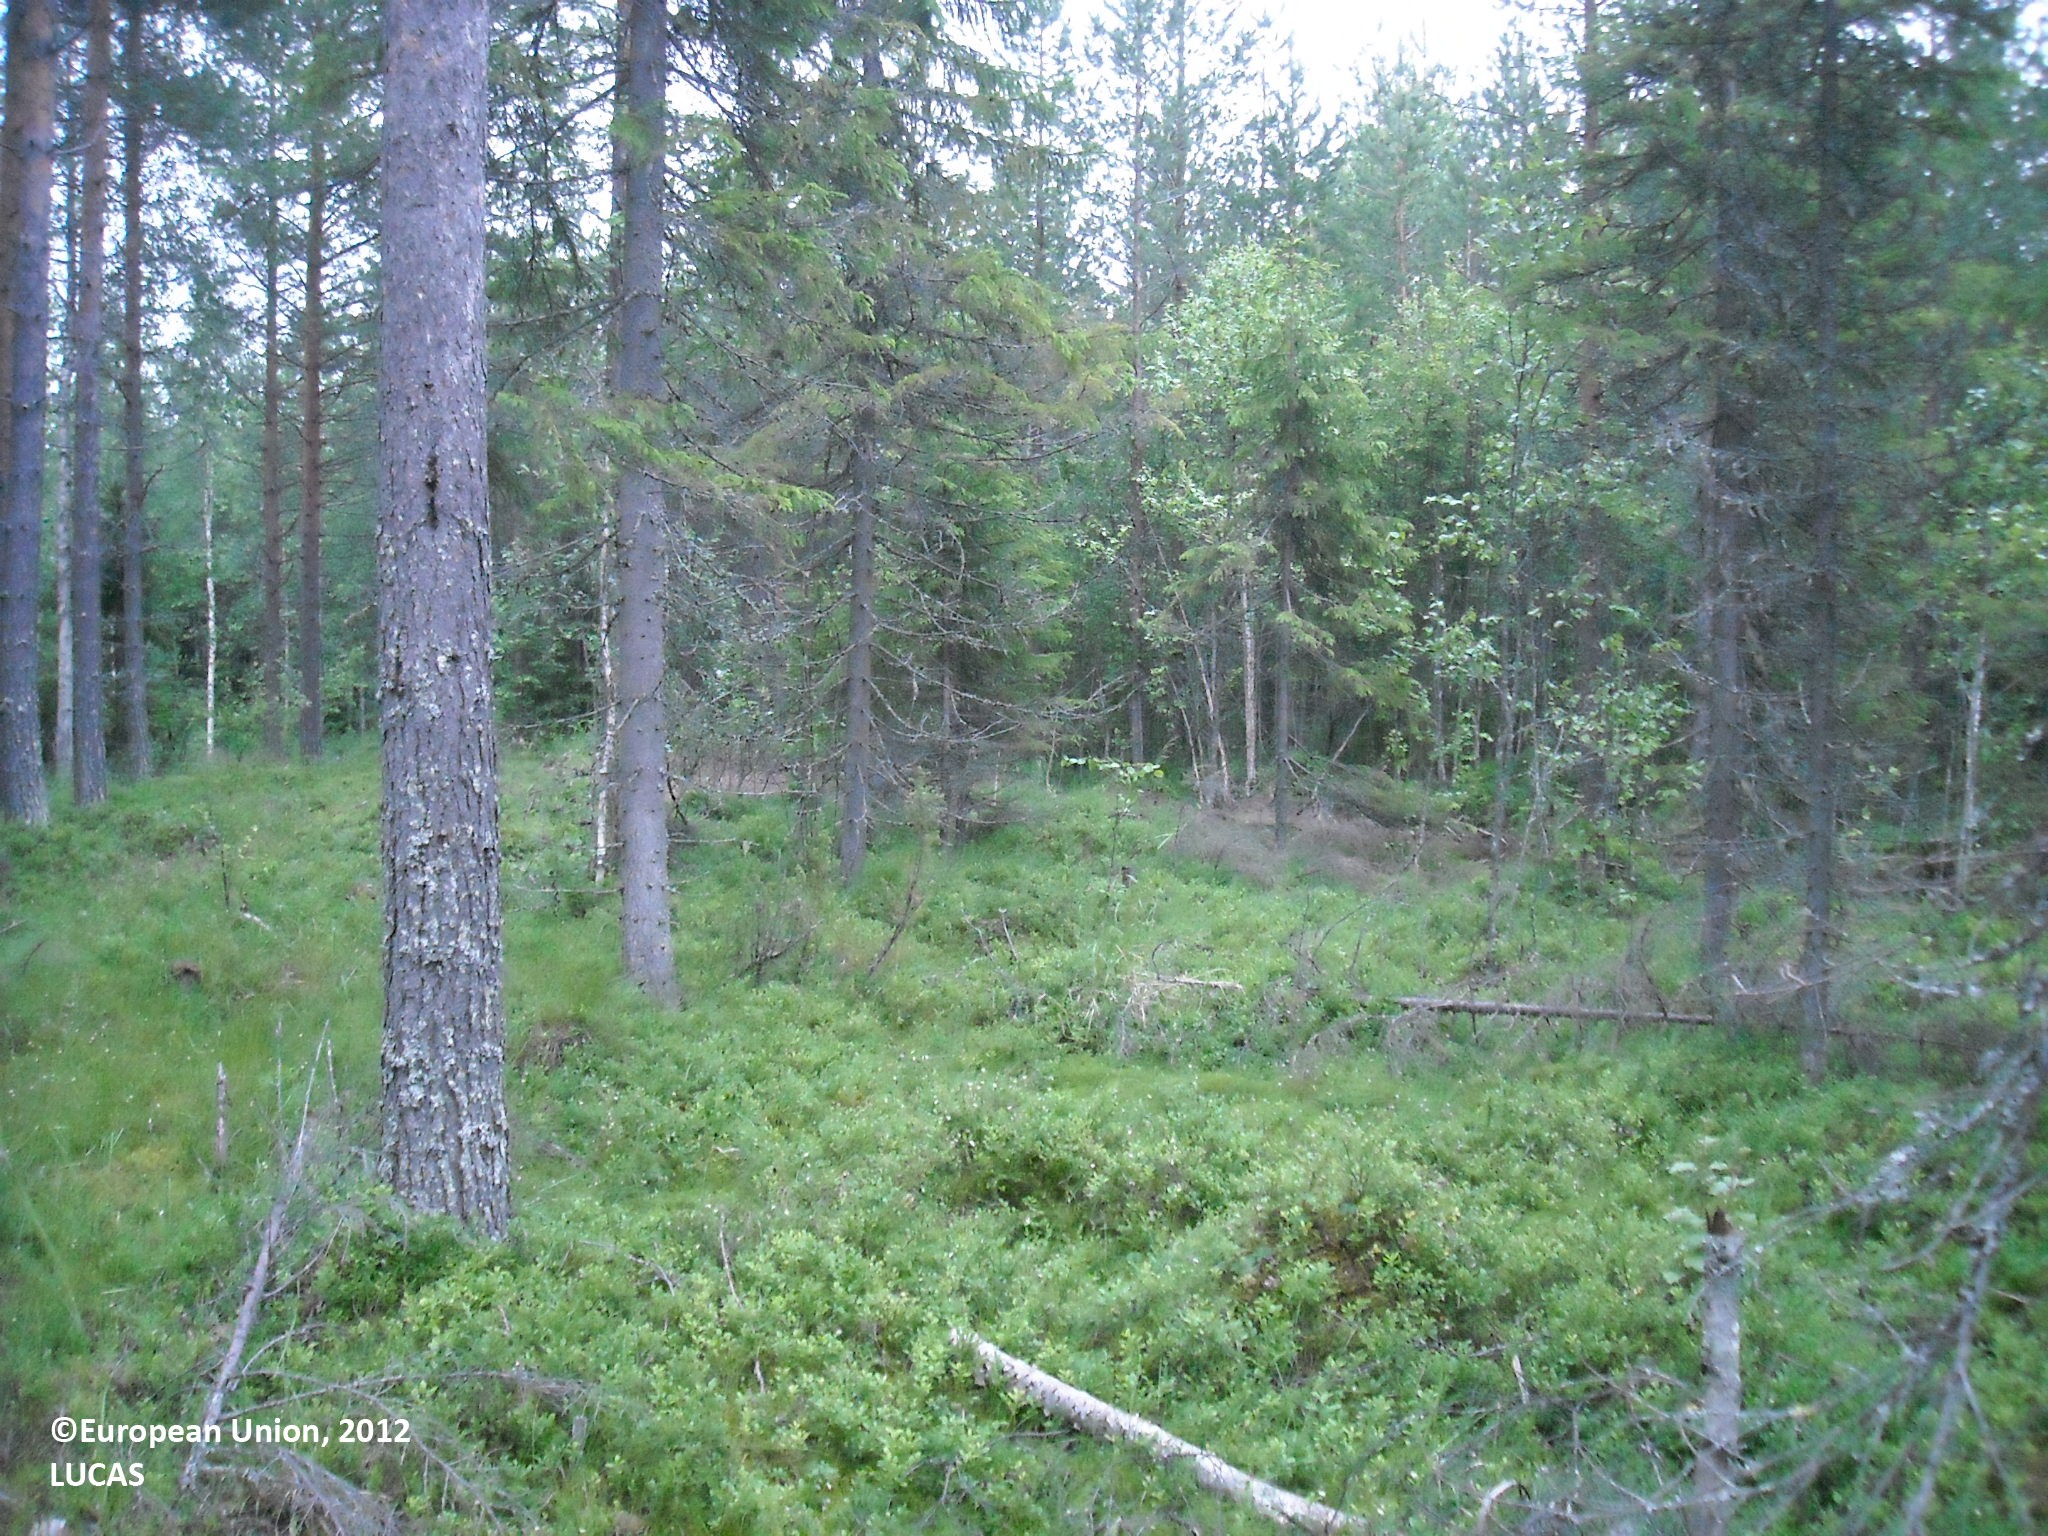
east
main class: Woodland
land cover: Other coniferous woodland
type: mire and swamp forests
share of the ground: > 75 %
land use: Forestry
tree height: > 5 m
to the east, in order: Other coniferous woodland; Tracks; Other mixed woodland; Ditches and canals; Other mixed woodland; Broadleaved woodland; Rivers and streams; Broadleaved woodland; Pine dominated mixed woodland; Pine dominated coniferous woodland
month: July
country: FI
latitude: 64.4118
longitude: 27.5567
